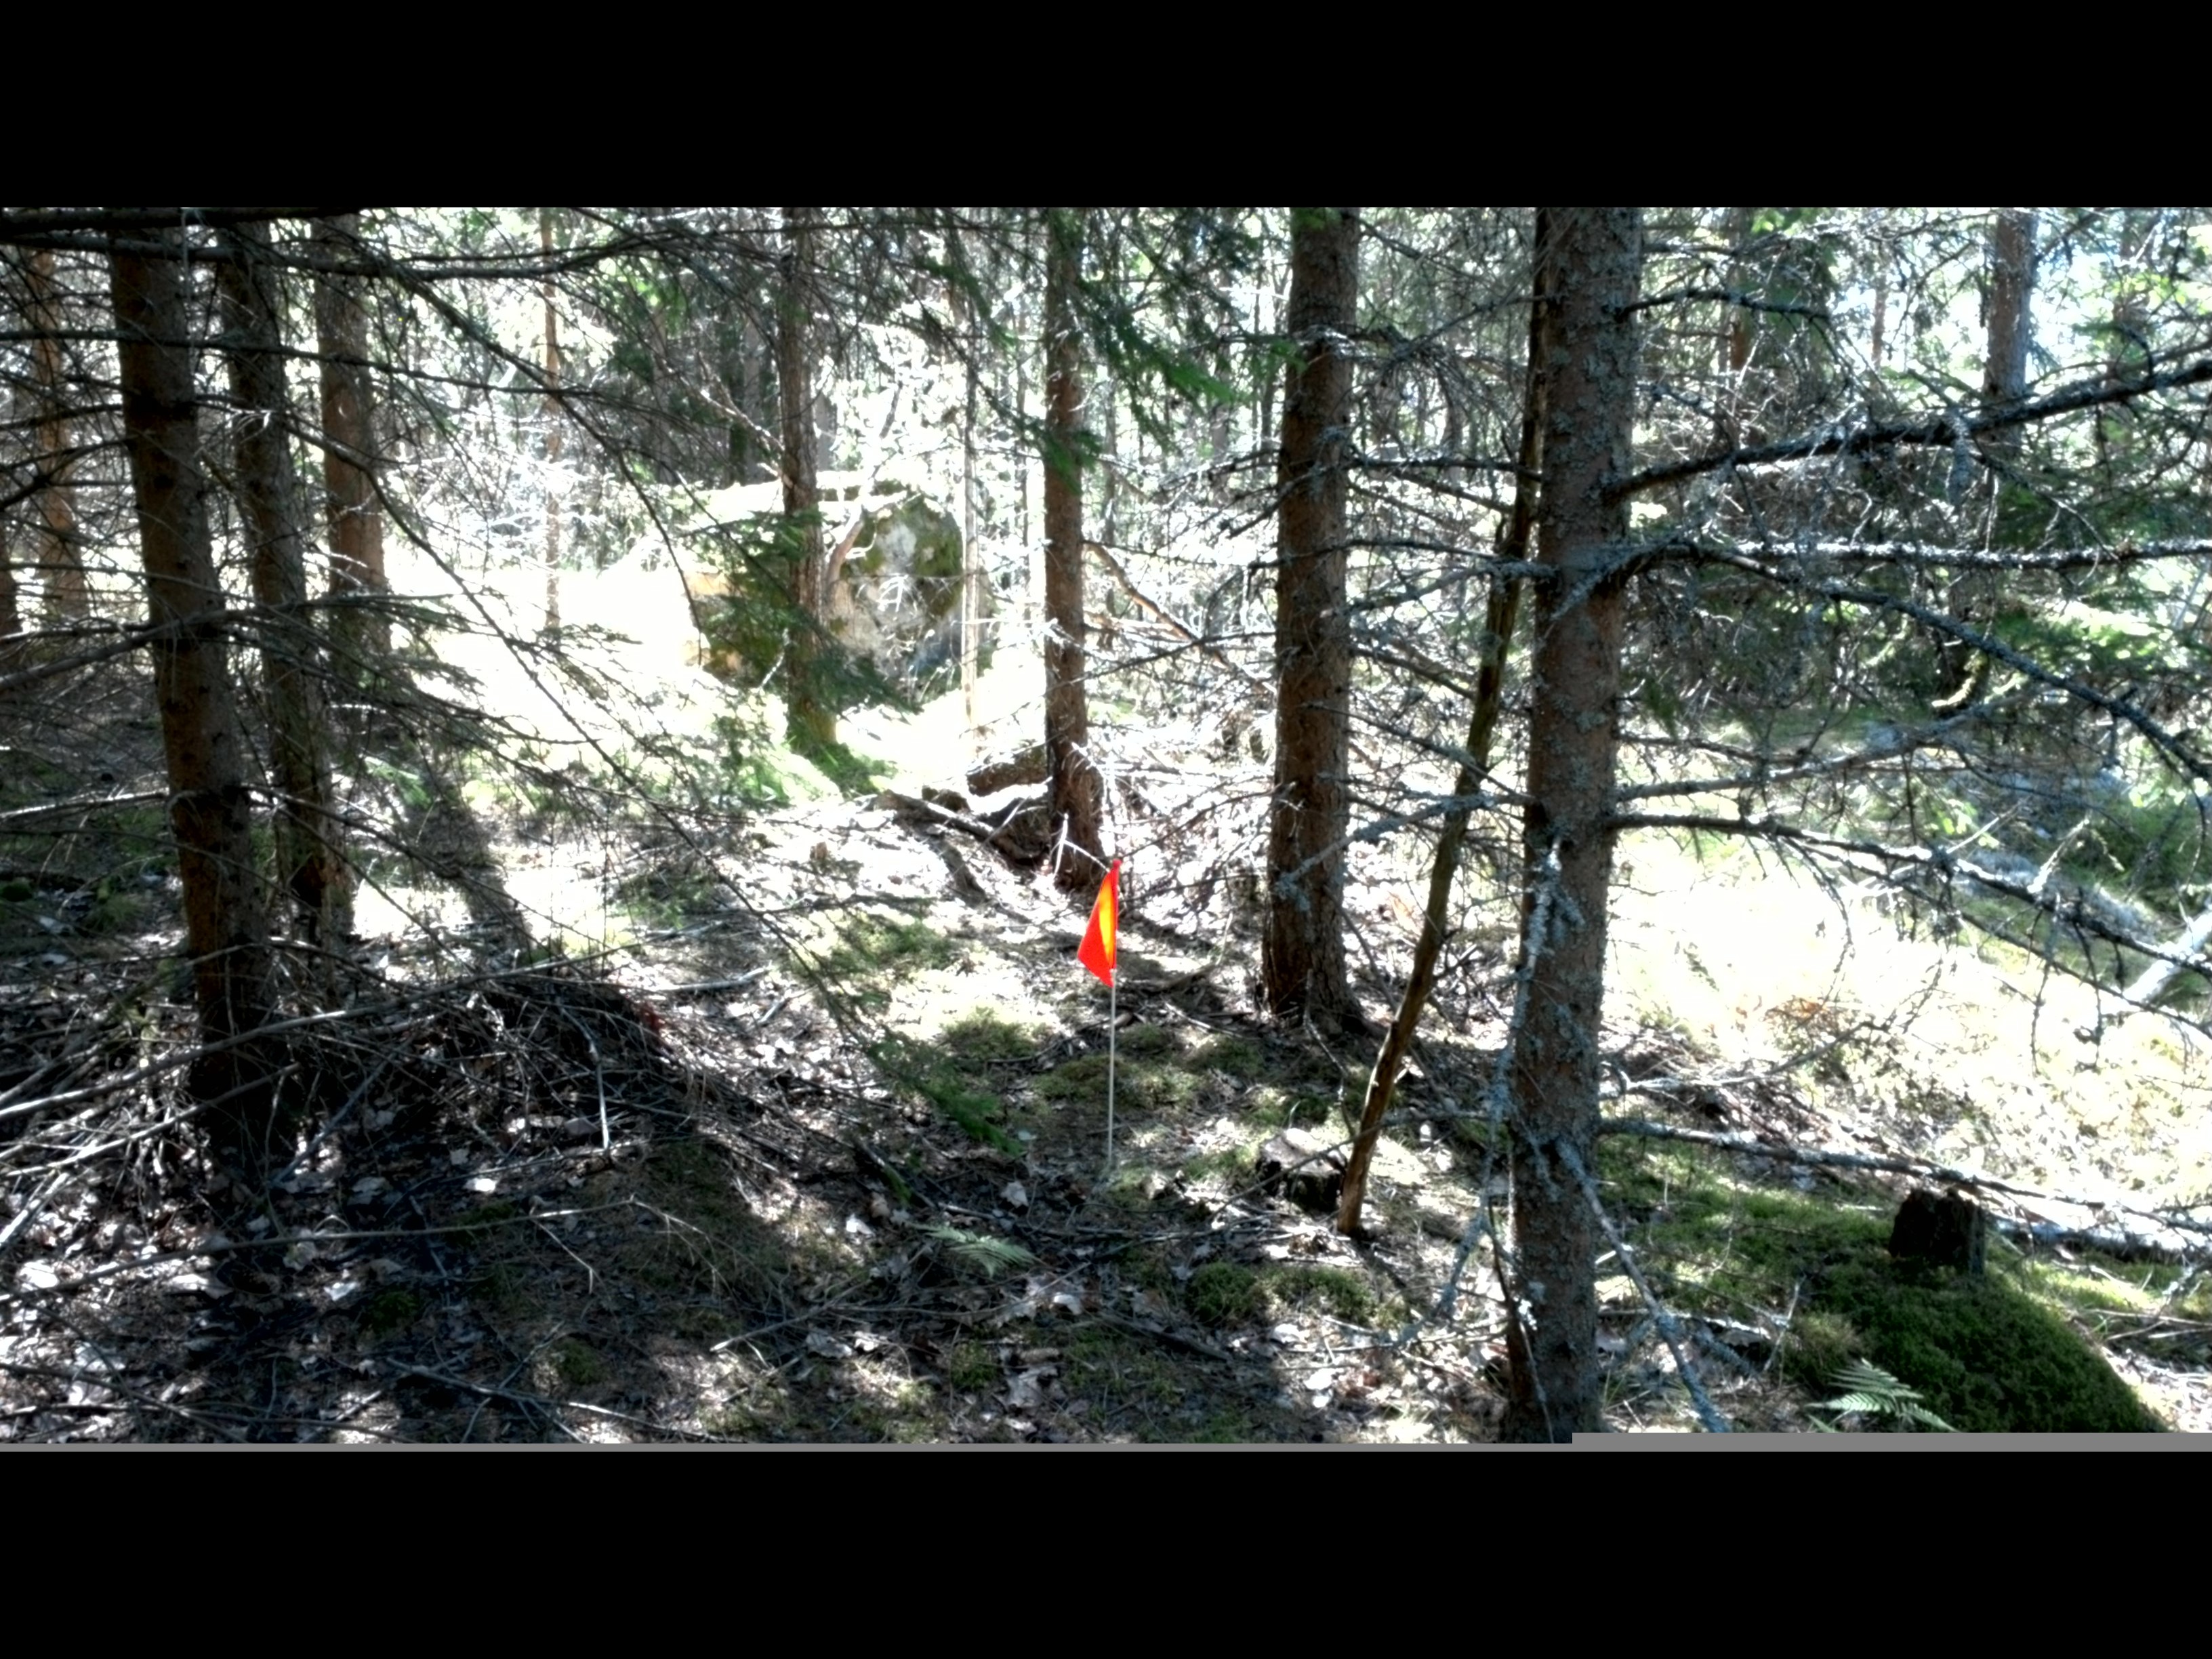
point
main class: Woodland
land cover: Spruce dominated coniferous woodland
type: boreal forest
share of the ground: > 75 %
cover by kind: coniferous forest trees 70 %, broadleaved forest trees 15 %, lichens and mosses 10 %, shrubs 5 %
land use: Forestry
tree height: > 5 m
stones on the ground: < 10 %
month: July
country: SE
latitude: 58.1831
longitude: 16.6129
